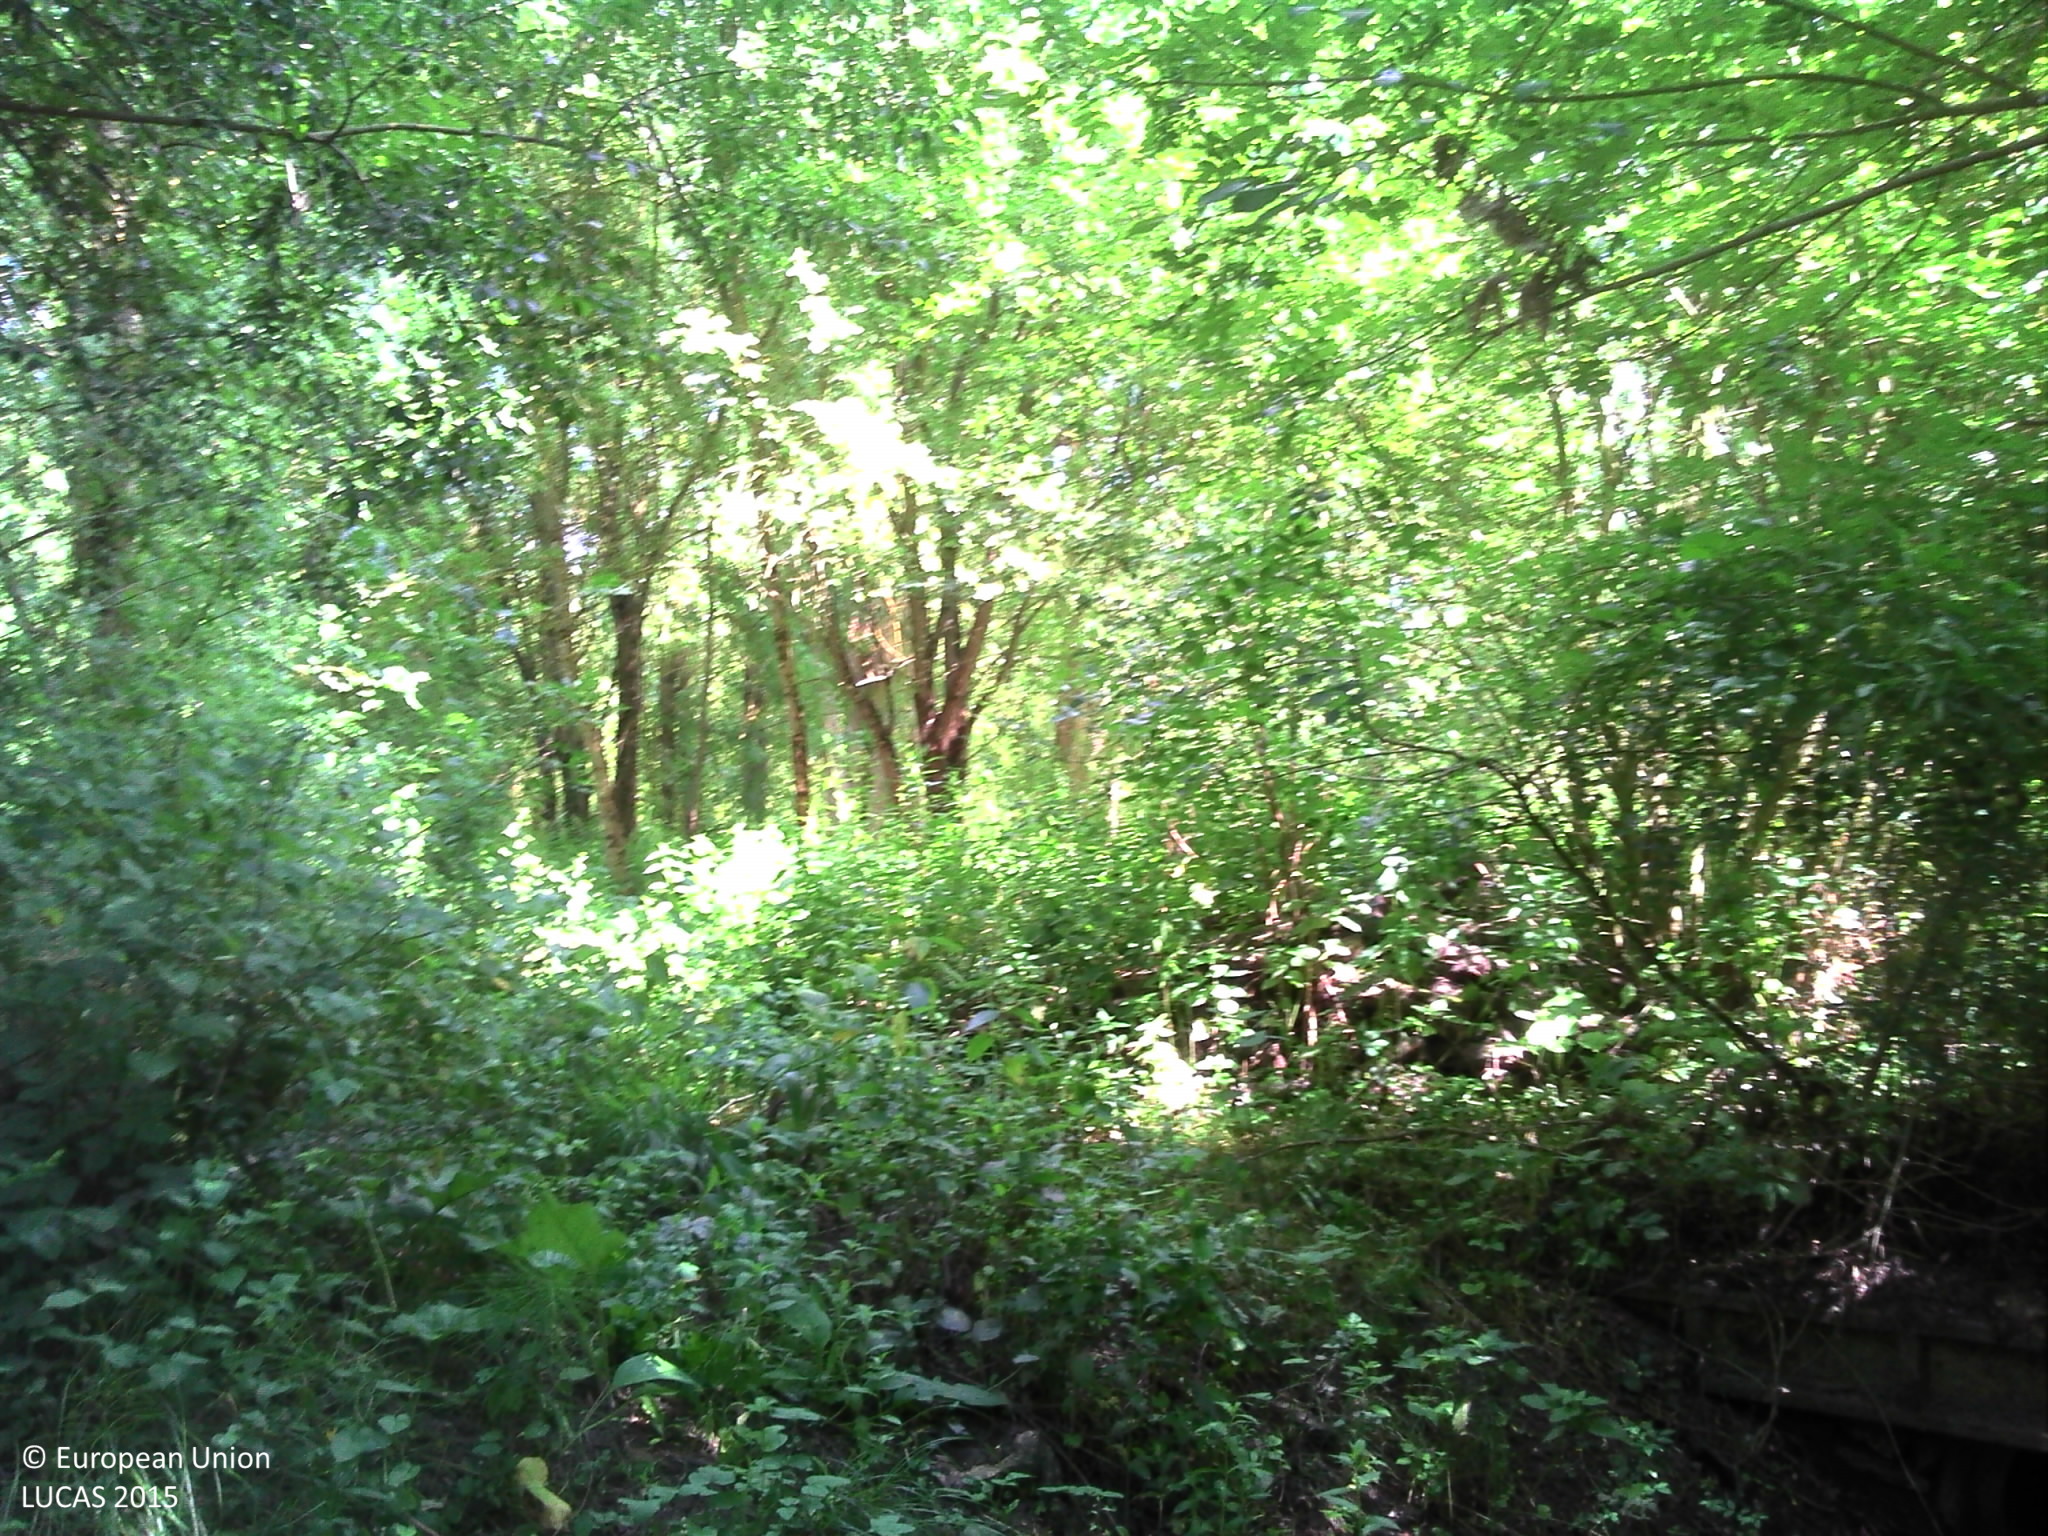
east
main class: Woodland
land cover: Broadleaved woodland
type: floodplain forest
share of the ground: > 75 %
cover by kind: broadleaved forest trees 75 %, herbaceous plants 15 %, shrubs 5 %, lichens and mosses 5 %
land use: Forestry
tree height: > 5 m
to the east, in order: Broadleaved woodland; Inland fresh water bodies; Broadleaved woodland; Grassland without tree/shrub cover; Lines of trees; Tracks; Grassland without tree/shrub cover
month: June
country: FR
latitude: 47.2762
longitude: 0.7944
